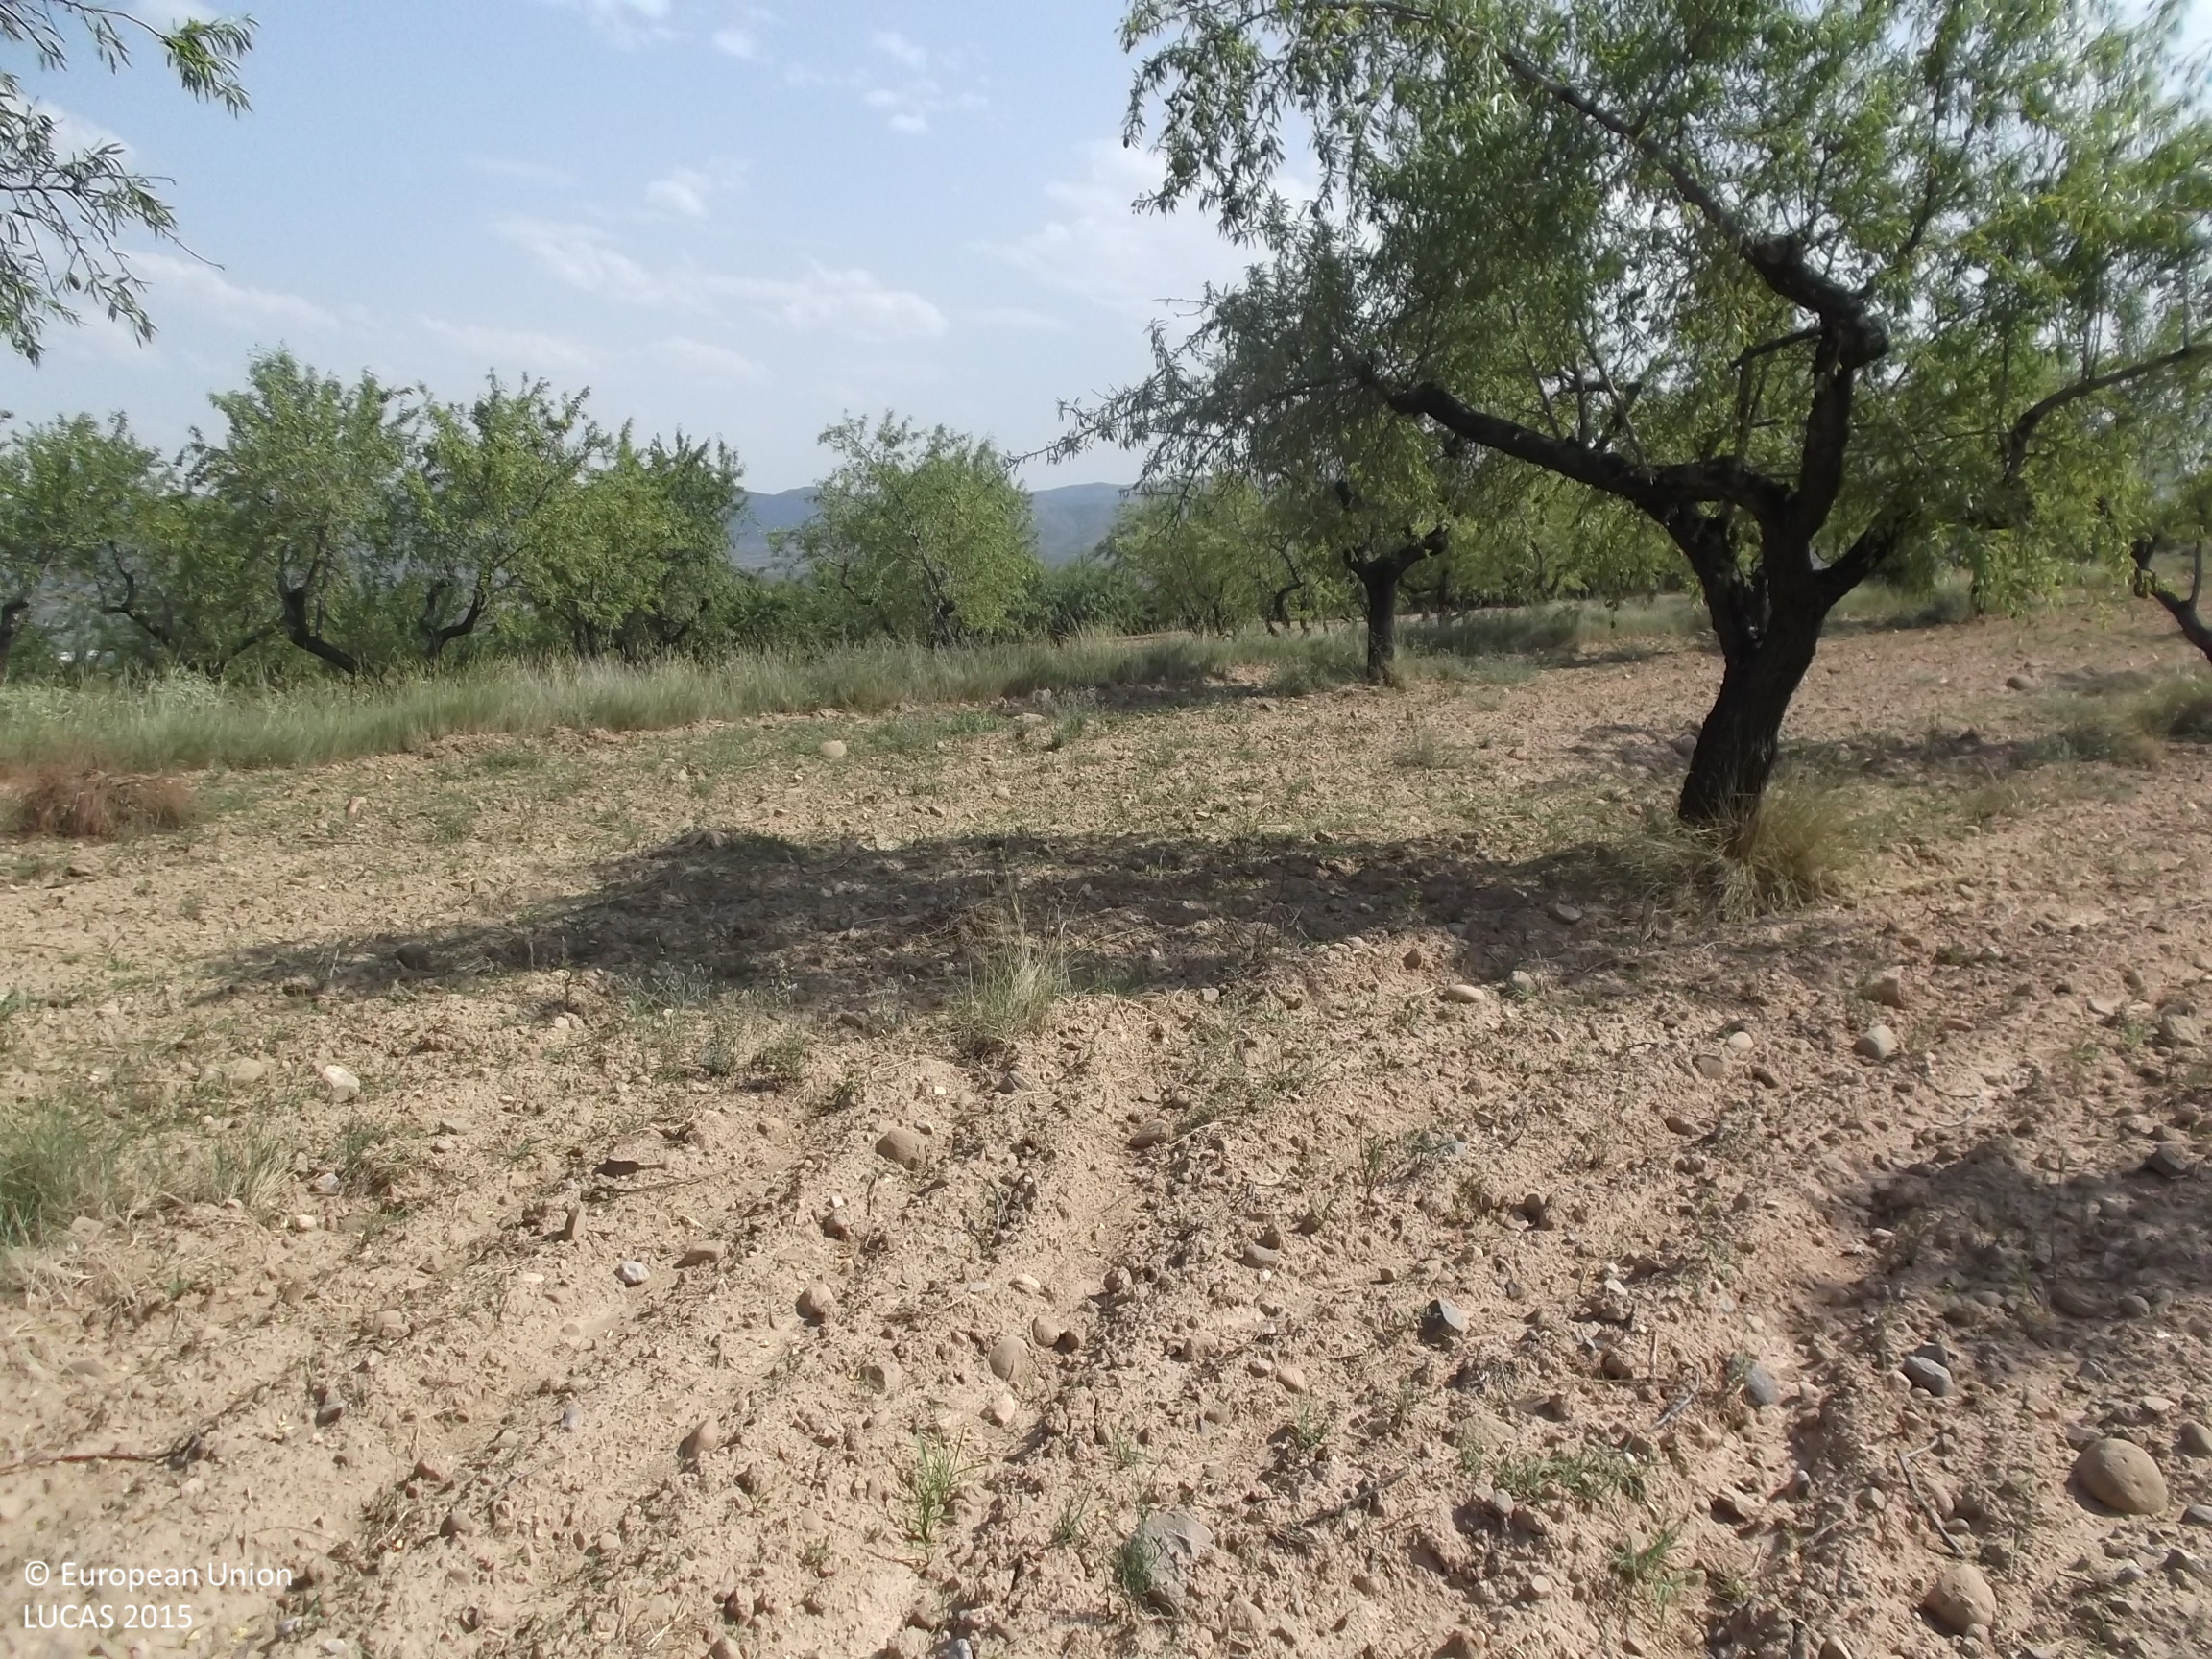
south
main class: Cropland
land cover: Nuts trees
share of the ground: 10 - 25 %
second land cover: Other bare soil
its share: > 75 %
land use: Agriculture (excluding fallow land and kitchen gardens)
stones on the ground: 10 - 25 %
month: July
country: ES
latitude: 42.2335
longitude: -2.1196
